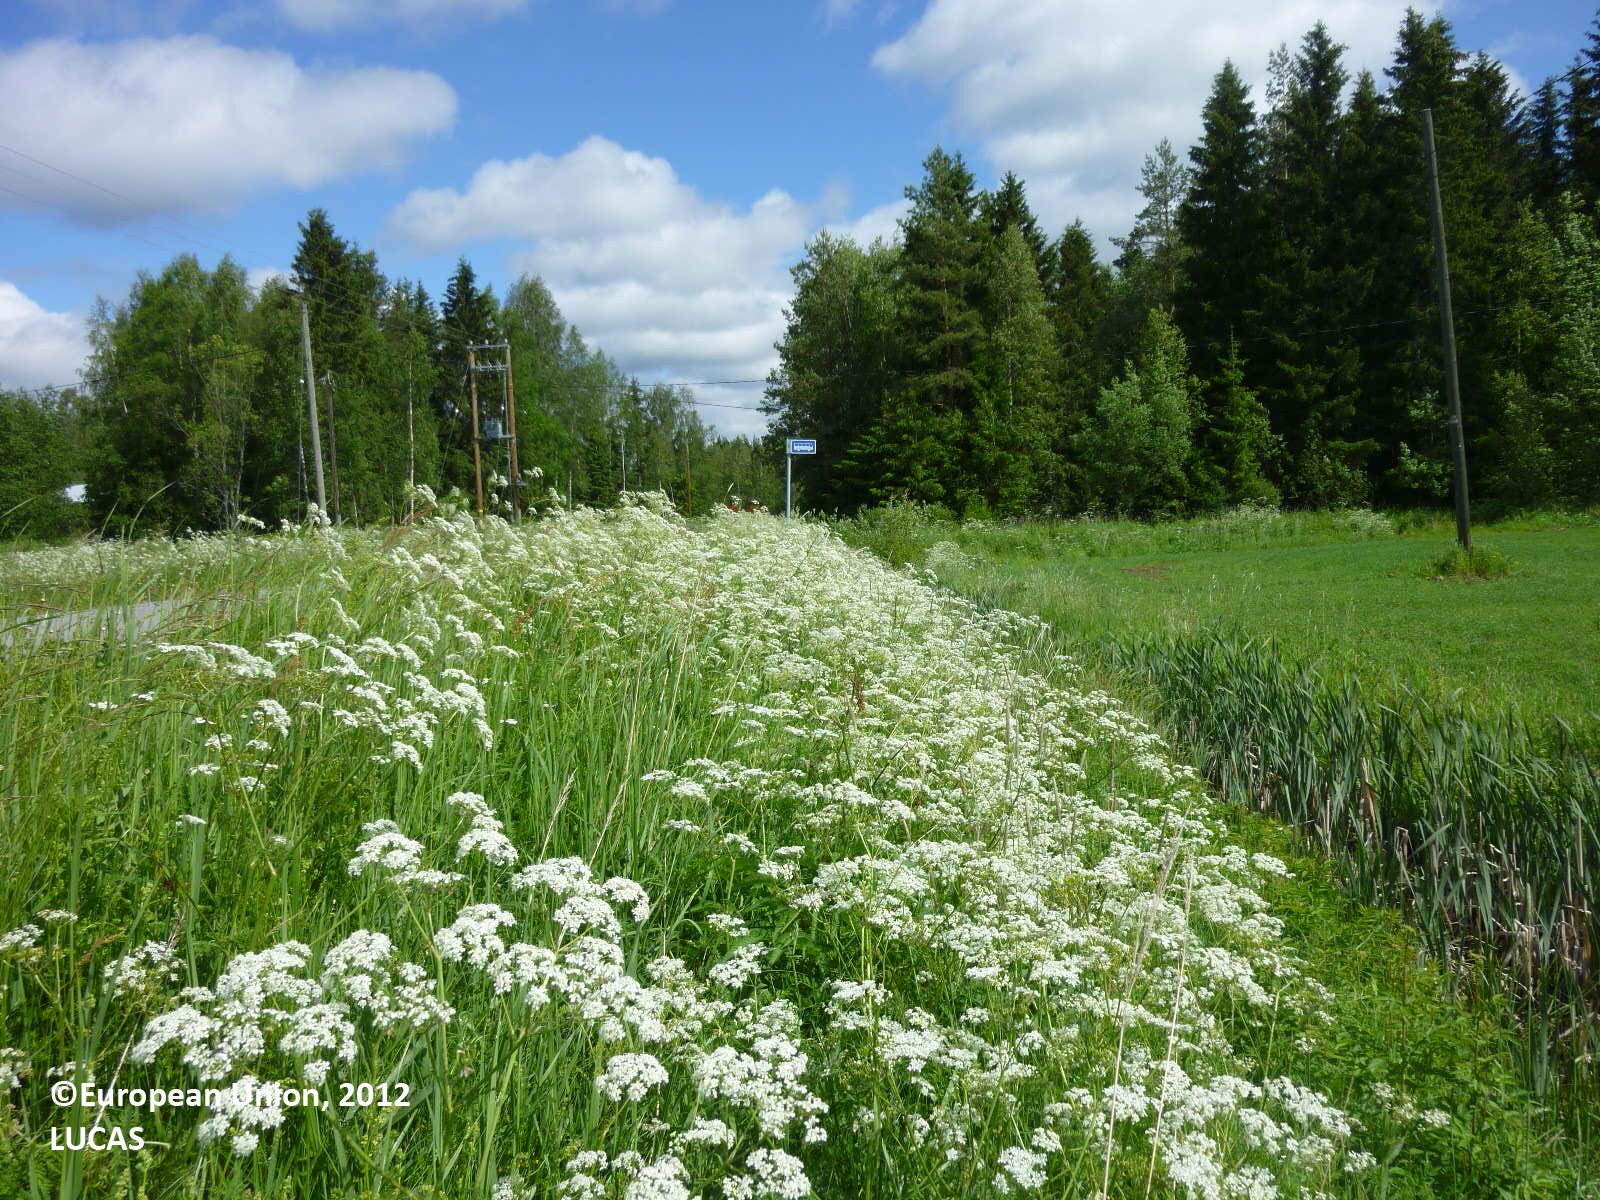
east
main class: Cropland
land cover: Barley
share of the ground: > 75 %
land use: Agriculture (excluding fallow land and kitchen gardens)
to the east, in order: Barley; Grass margins; Ditches and canals; Grass margins; Paved roads, cycling and walking lanes; Grass margins; Spruce dominated mixed woodland; Grass margins; Ditches and canals; Barley; Grass margins; Ditches and canals; Grass margins; Spruce dominated mixed woodland; Grassland without tree/shrub cover; Inland running water; Grassland without tree/shrub cover; Spruce dominated mixed woodland; Grassland without tree/shrub cover
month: June
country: FI
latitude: 61.7250
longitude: 22.2641
